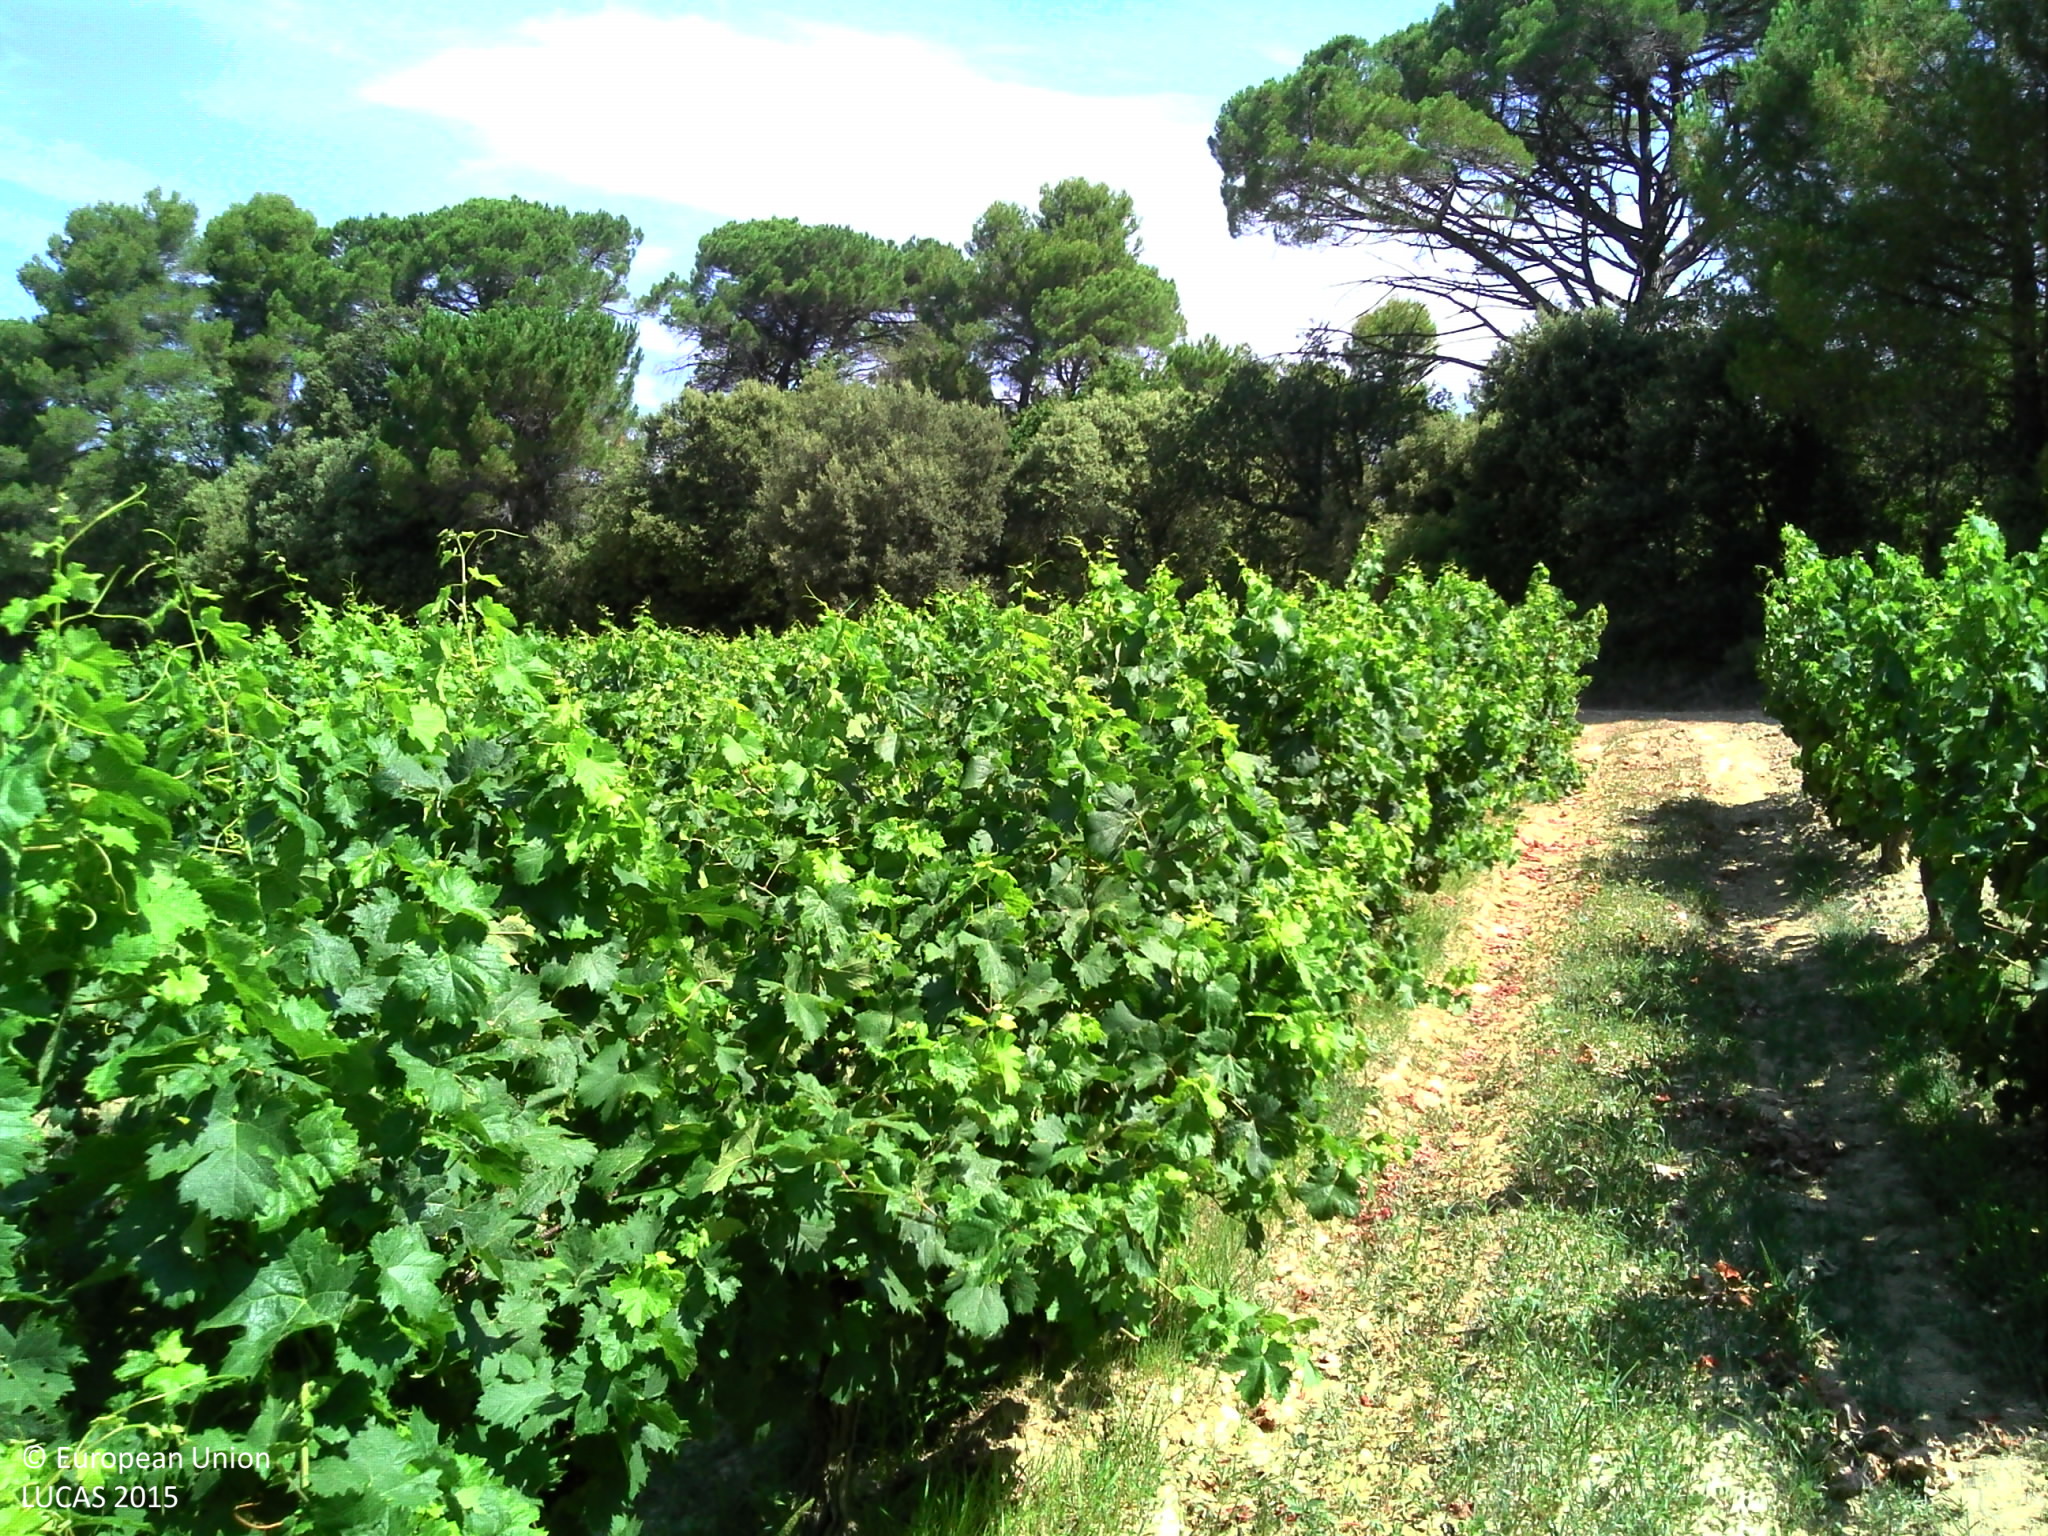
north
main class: Cropland
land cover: Vineyards
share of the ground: 25 - 50 %
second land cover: Grassland without tree/shrub cover
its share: 50 - 75 %
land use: Agriculture (excluding fallow land and kitchen gardens)
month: July
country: FR
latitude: 43.7144
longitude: 5.5781
